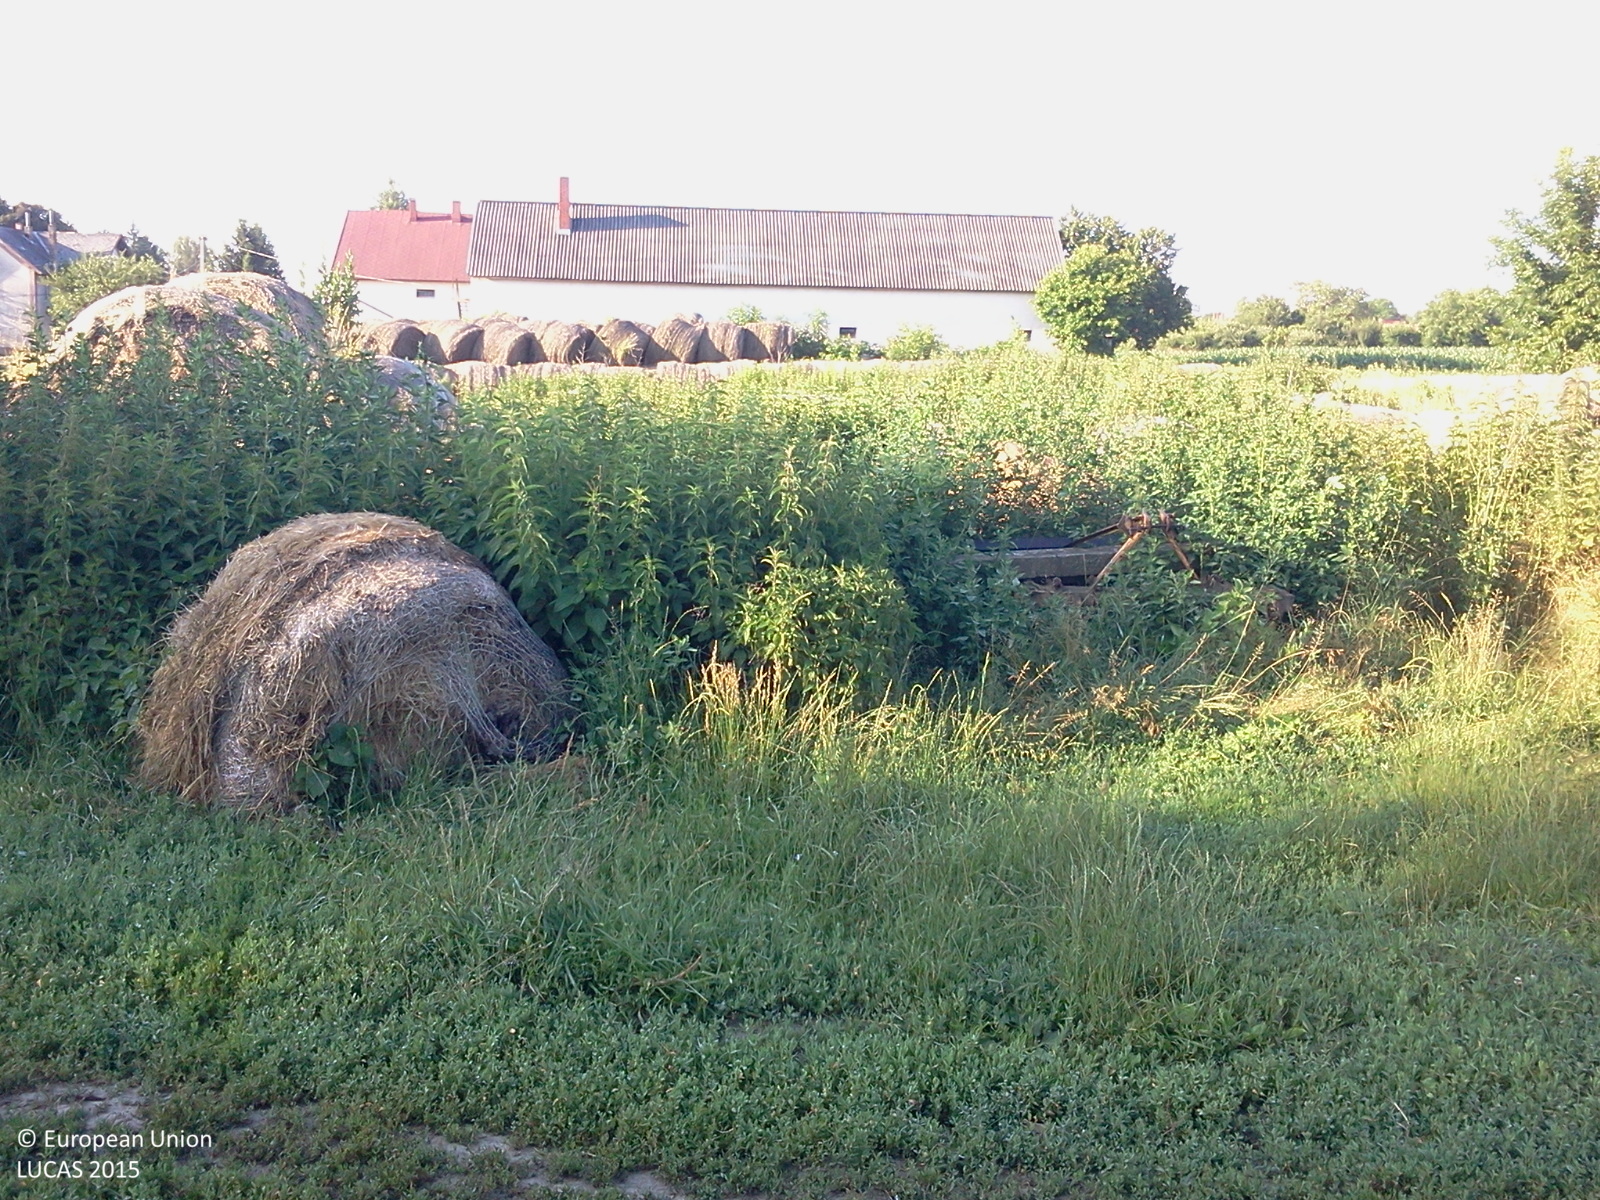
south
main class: Grassland
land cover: Spontaneously vegetated surfaces
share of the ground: > 75 %
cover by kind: herbaceous plants 100 %
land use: Agriculture (excluding fallow land and kitchen gardens)
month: June
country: HU
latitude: 46.7291
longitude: 17.1093
